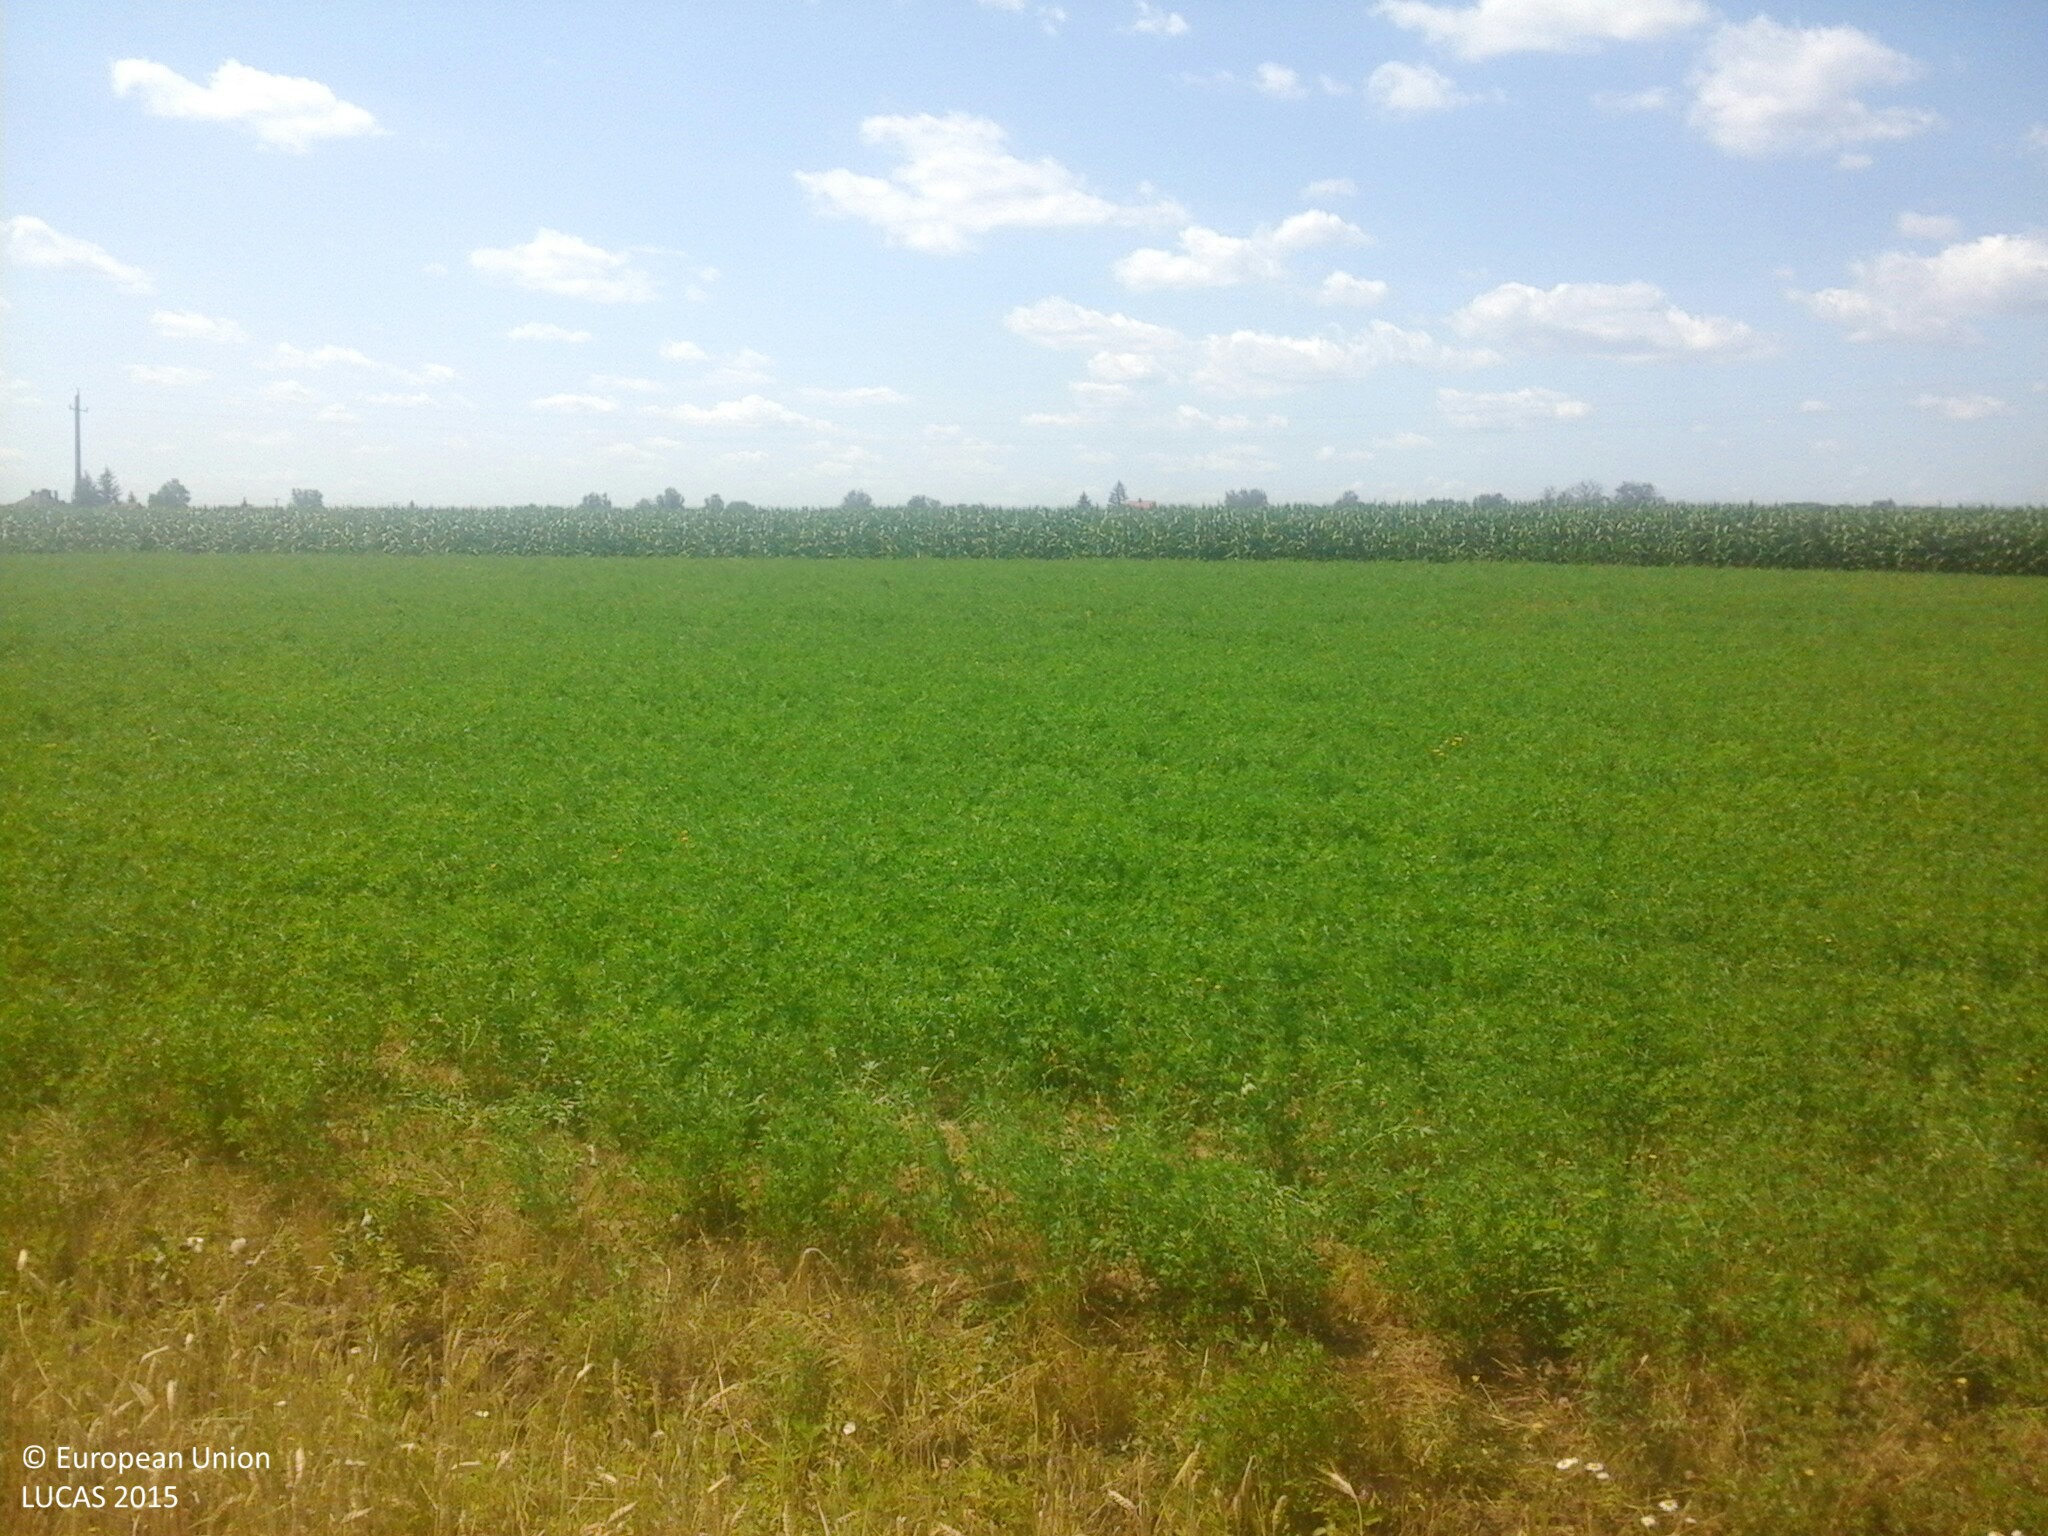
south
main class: Cropland
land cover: Triticale
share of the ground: > 75 %
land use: Agriculture (excluding fallow land and kitchen gardens)
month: July
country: HU
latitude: 48.0527
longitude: 22.3603
